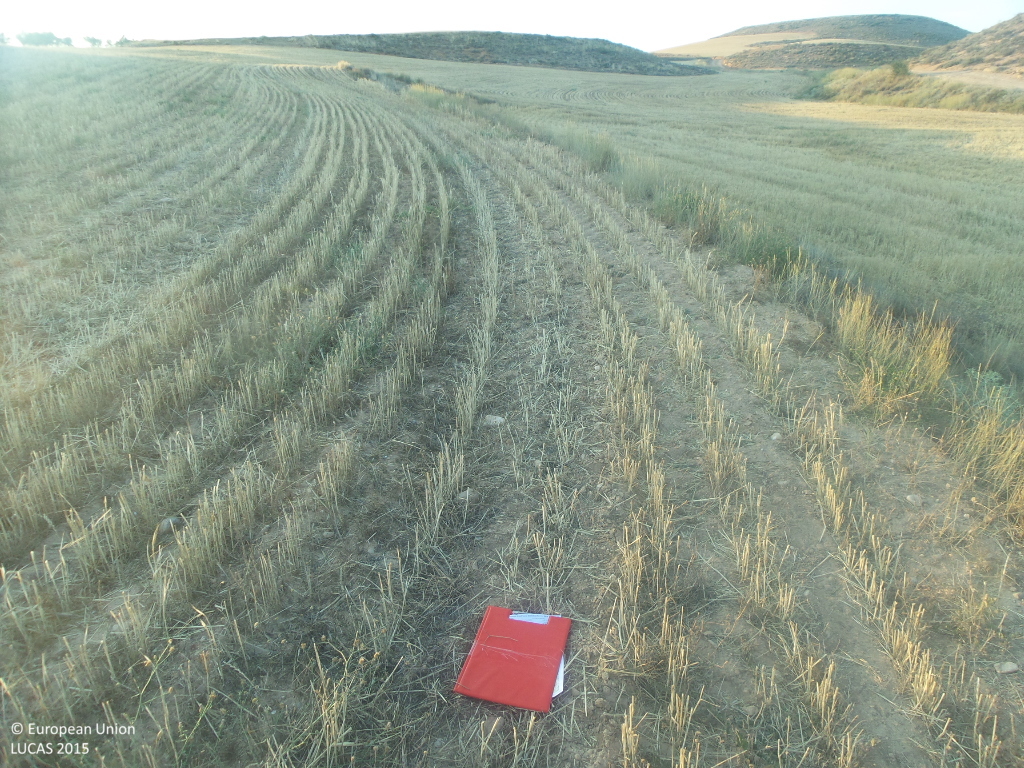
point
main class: Cropland
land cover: Barley
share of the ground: < 10 %
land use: Agriculture (excluding fallow land and kitchen gardens)
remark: Harvested field
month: July
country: ES
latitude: 41.3048
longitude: -2.1043
